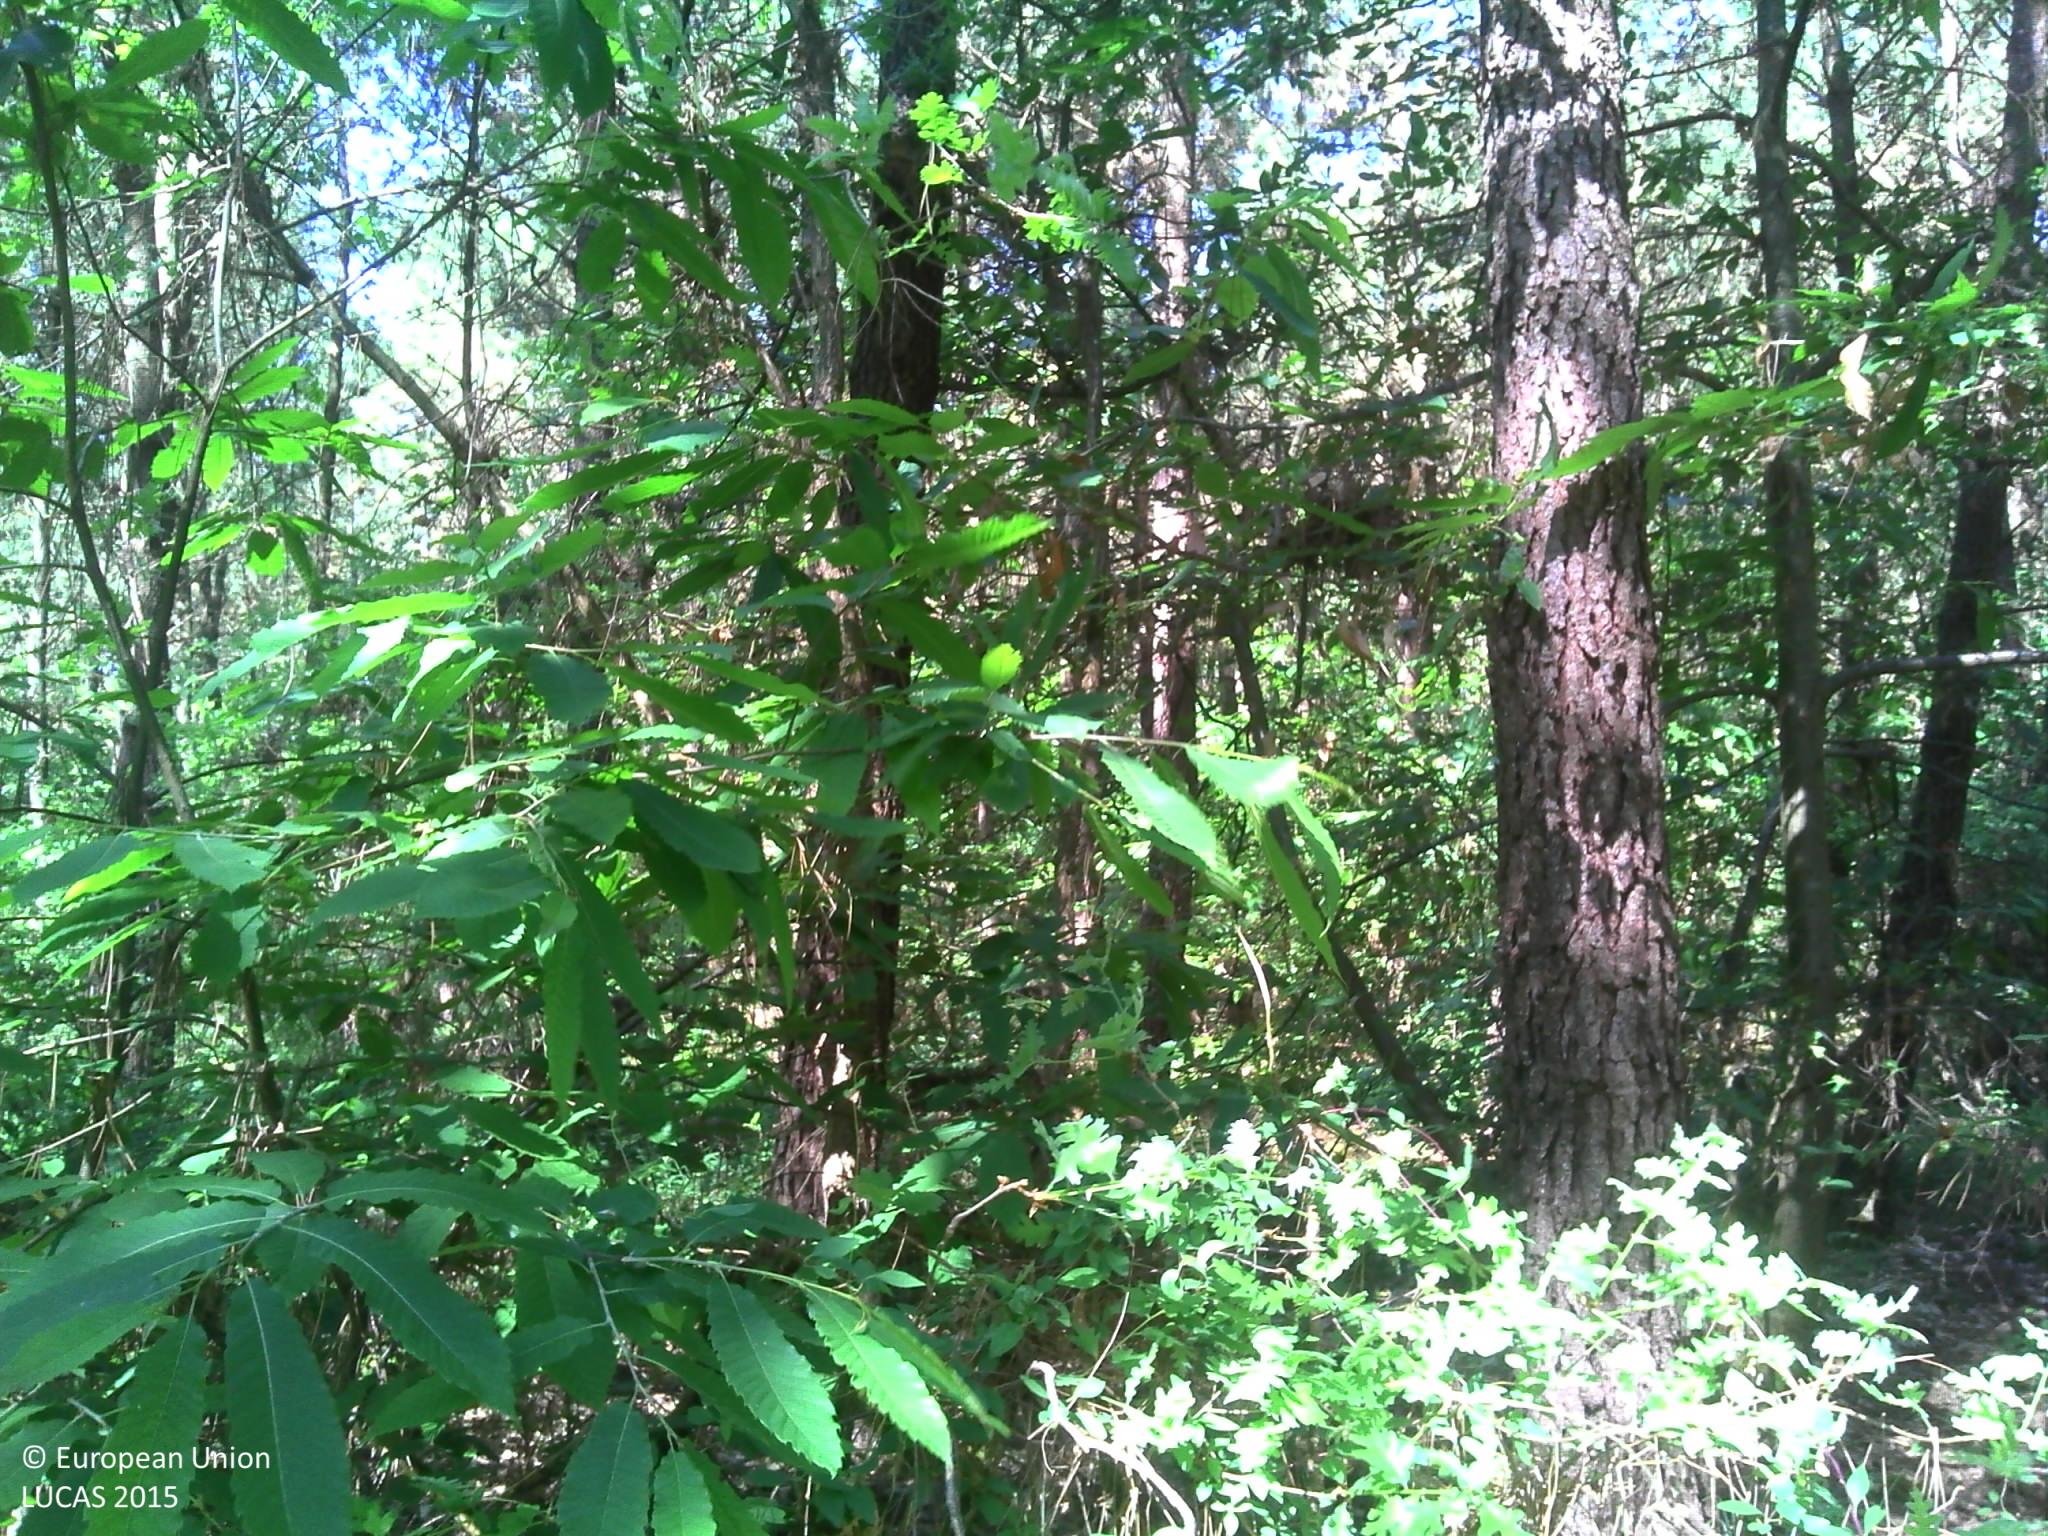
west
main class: Woodland
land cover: Pine dominated mixed woodland
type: hemiboreal forest and nemoral coniferous forest and mixed broadleaved-coniferous forest
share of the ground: > 75 %
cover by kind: coniferous forest trees 40 %, broadleaved forest trees 25 %, shrubs 20 %, herbaceous plants 15 %
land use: Forestry
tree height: > 5 m
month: June
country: FR
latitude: 47.8346
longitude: -0.0613
